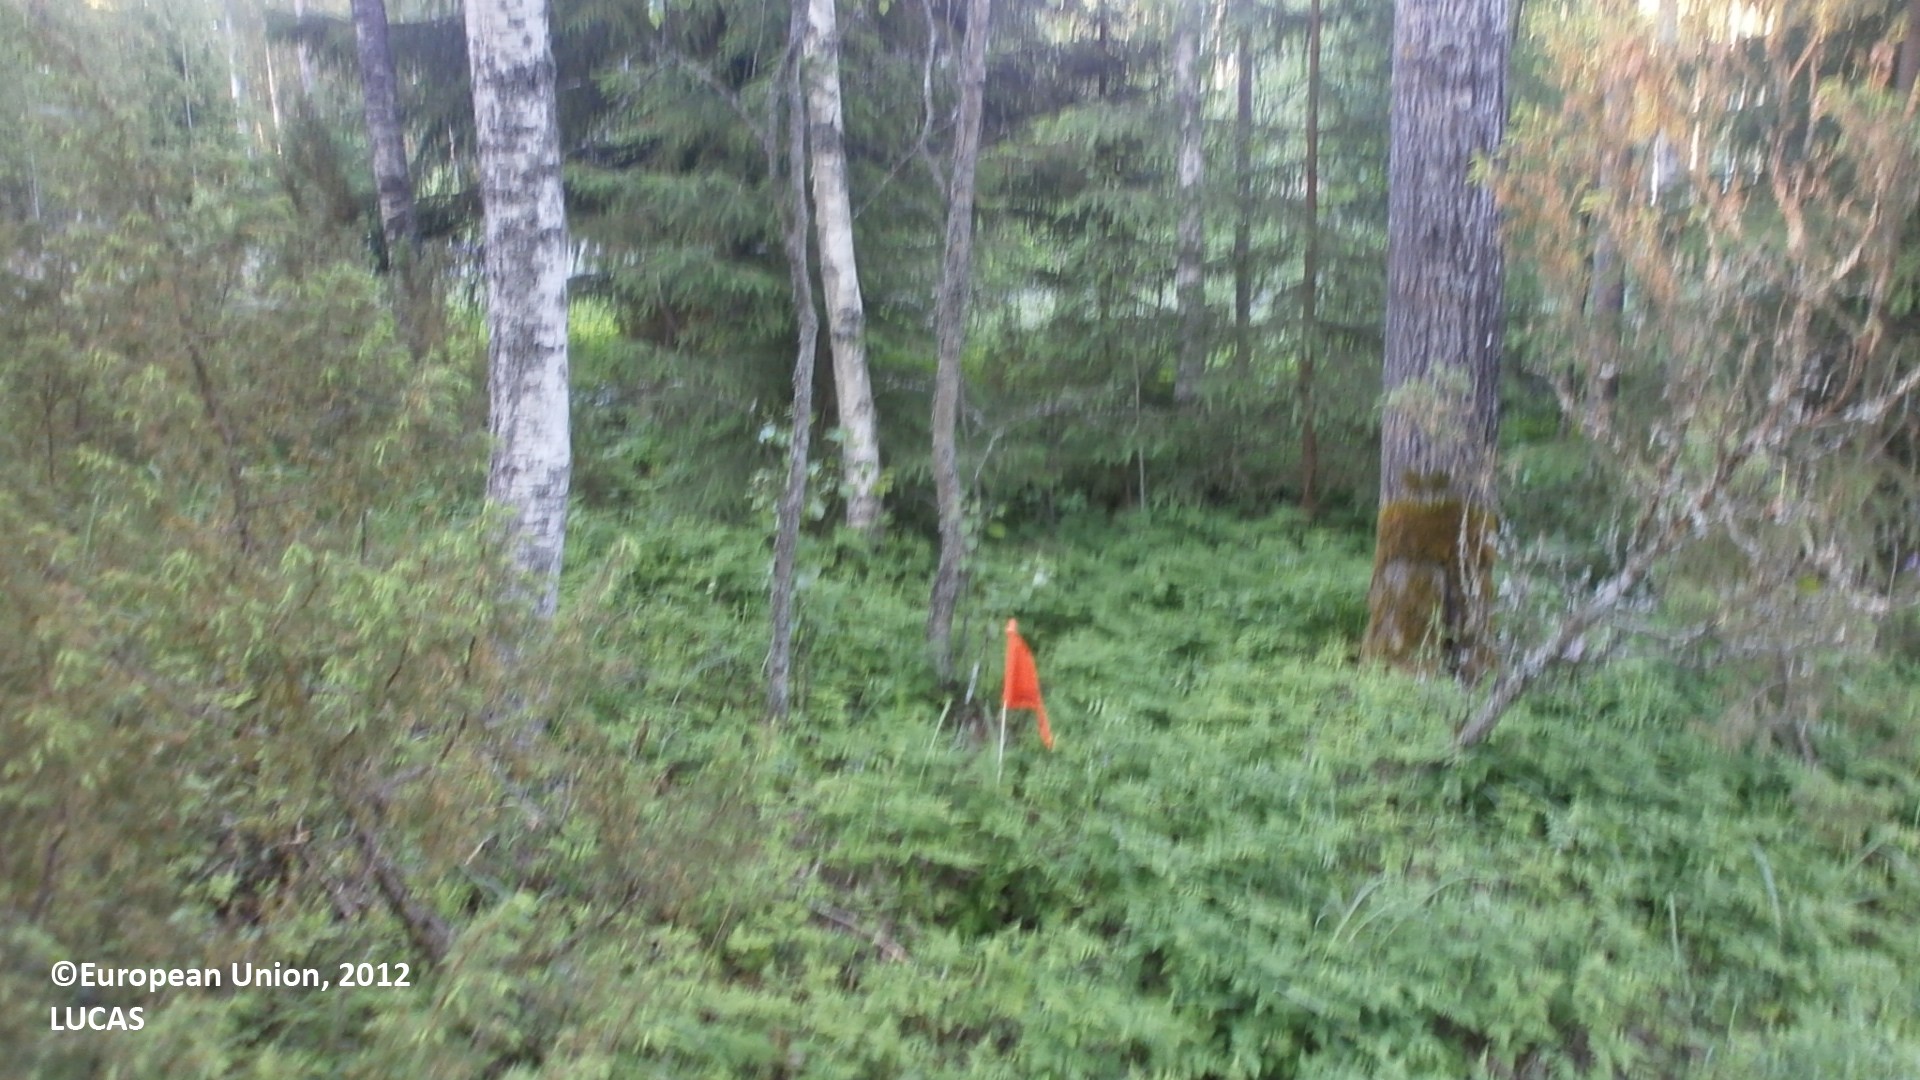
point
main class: Woodland
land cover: Other mixed woodland
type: boreal forest
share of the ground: > 75 %
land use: Amenities, museums, leisure
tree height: > 5 m
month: June
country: FI
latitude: 64.3121
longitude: 24.9467
